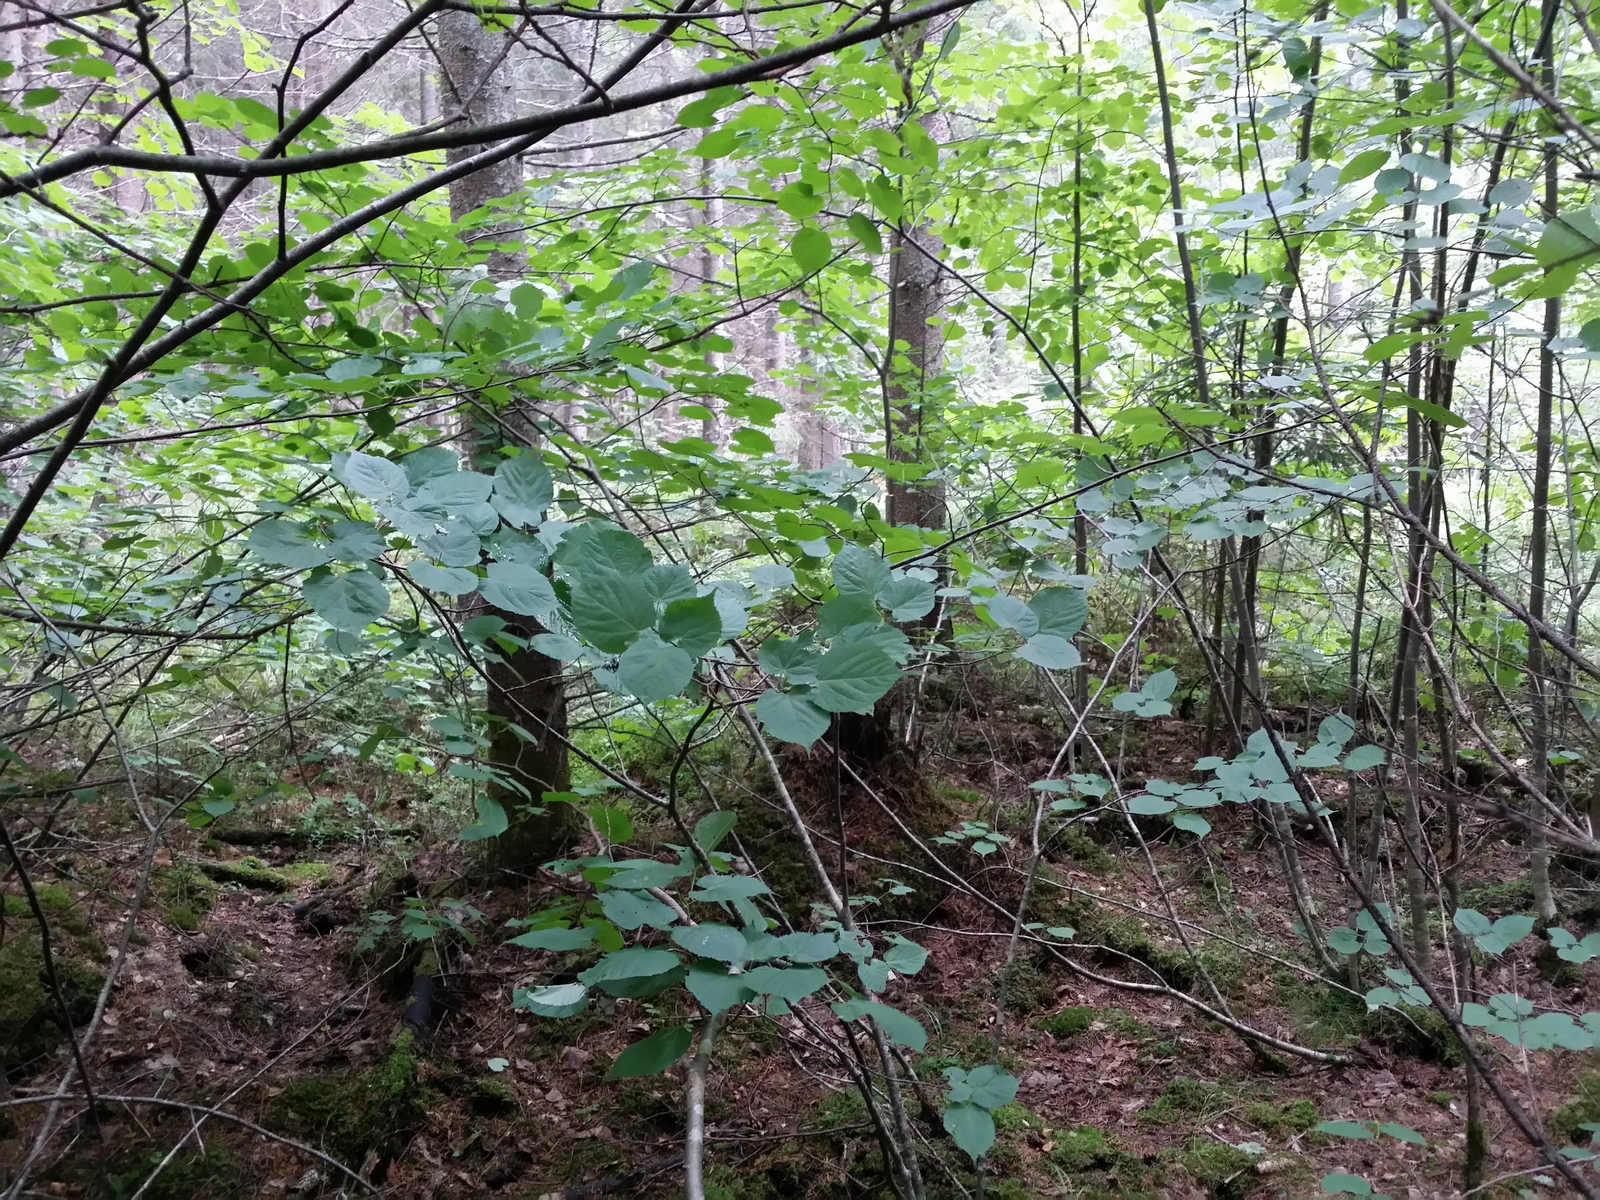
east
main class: Woodland
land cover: Spruce dominated mixed woodland
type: hemiboreal forest and nemoral coniferous forest and mixed broadleaved-coniferous forest
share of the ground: > 75 %
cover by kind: coniferous forest trees 50 %, broadleaved forest trees 35 %, shrubs 5 %, herbaceous plants 5 %, lichens and mosses 5 %
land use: Forestry
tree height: > 5 m
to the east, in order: Spruce dominated mixed woodland; Spruce dominated coniferous woodland; Grassland with sparse tree/shrub cover; Spruce dominated mixed woodland
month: July
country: LV
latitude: 57.2687
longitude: 27.2983
